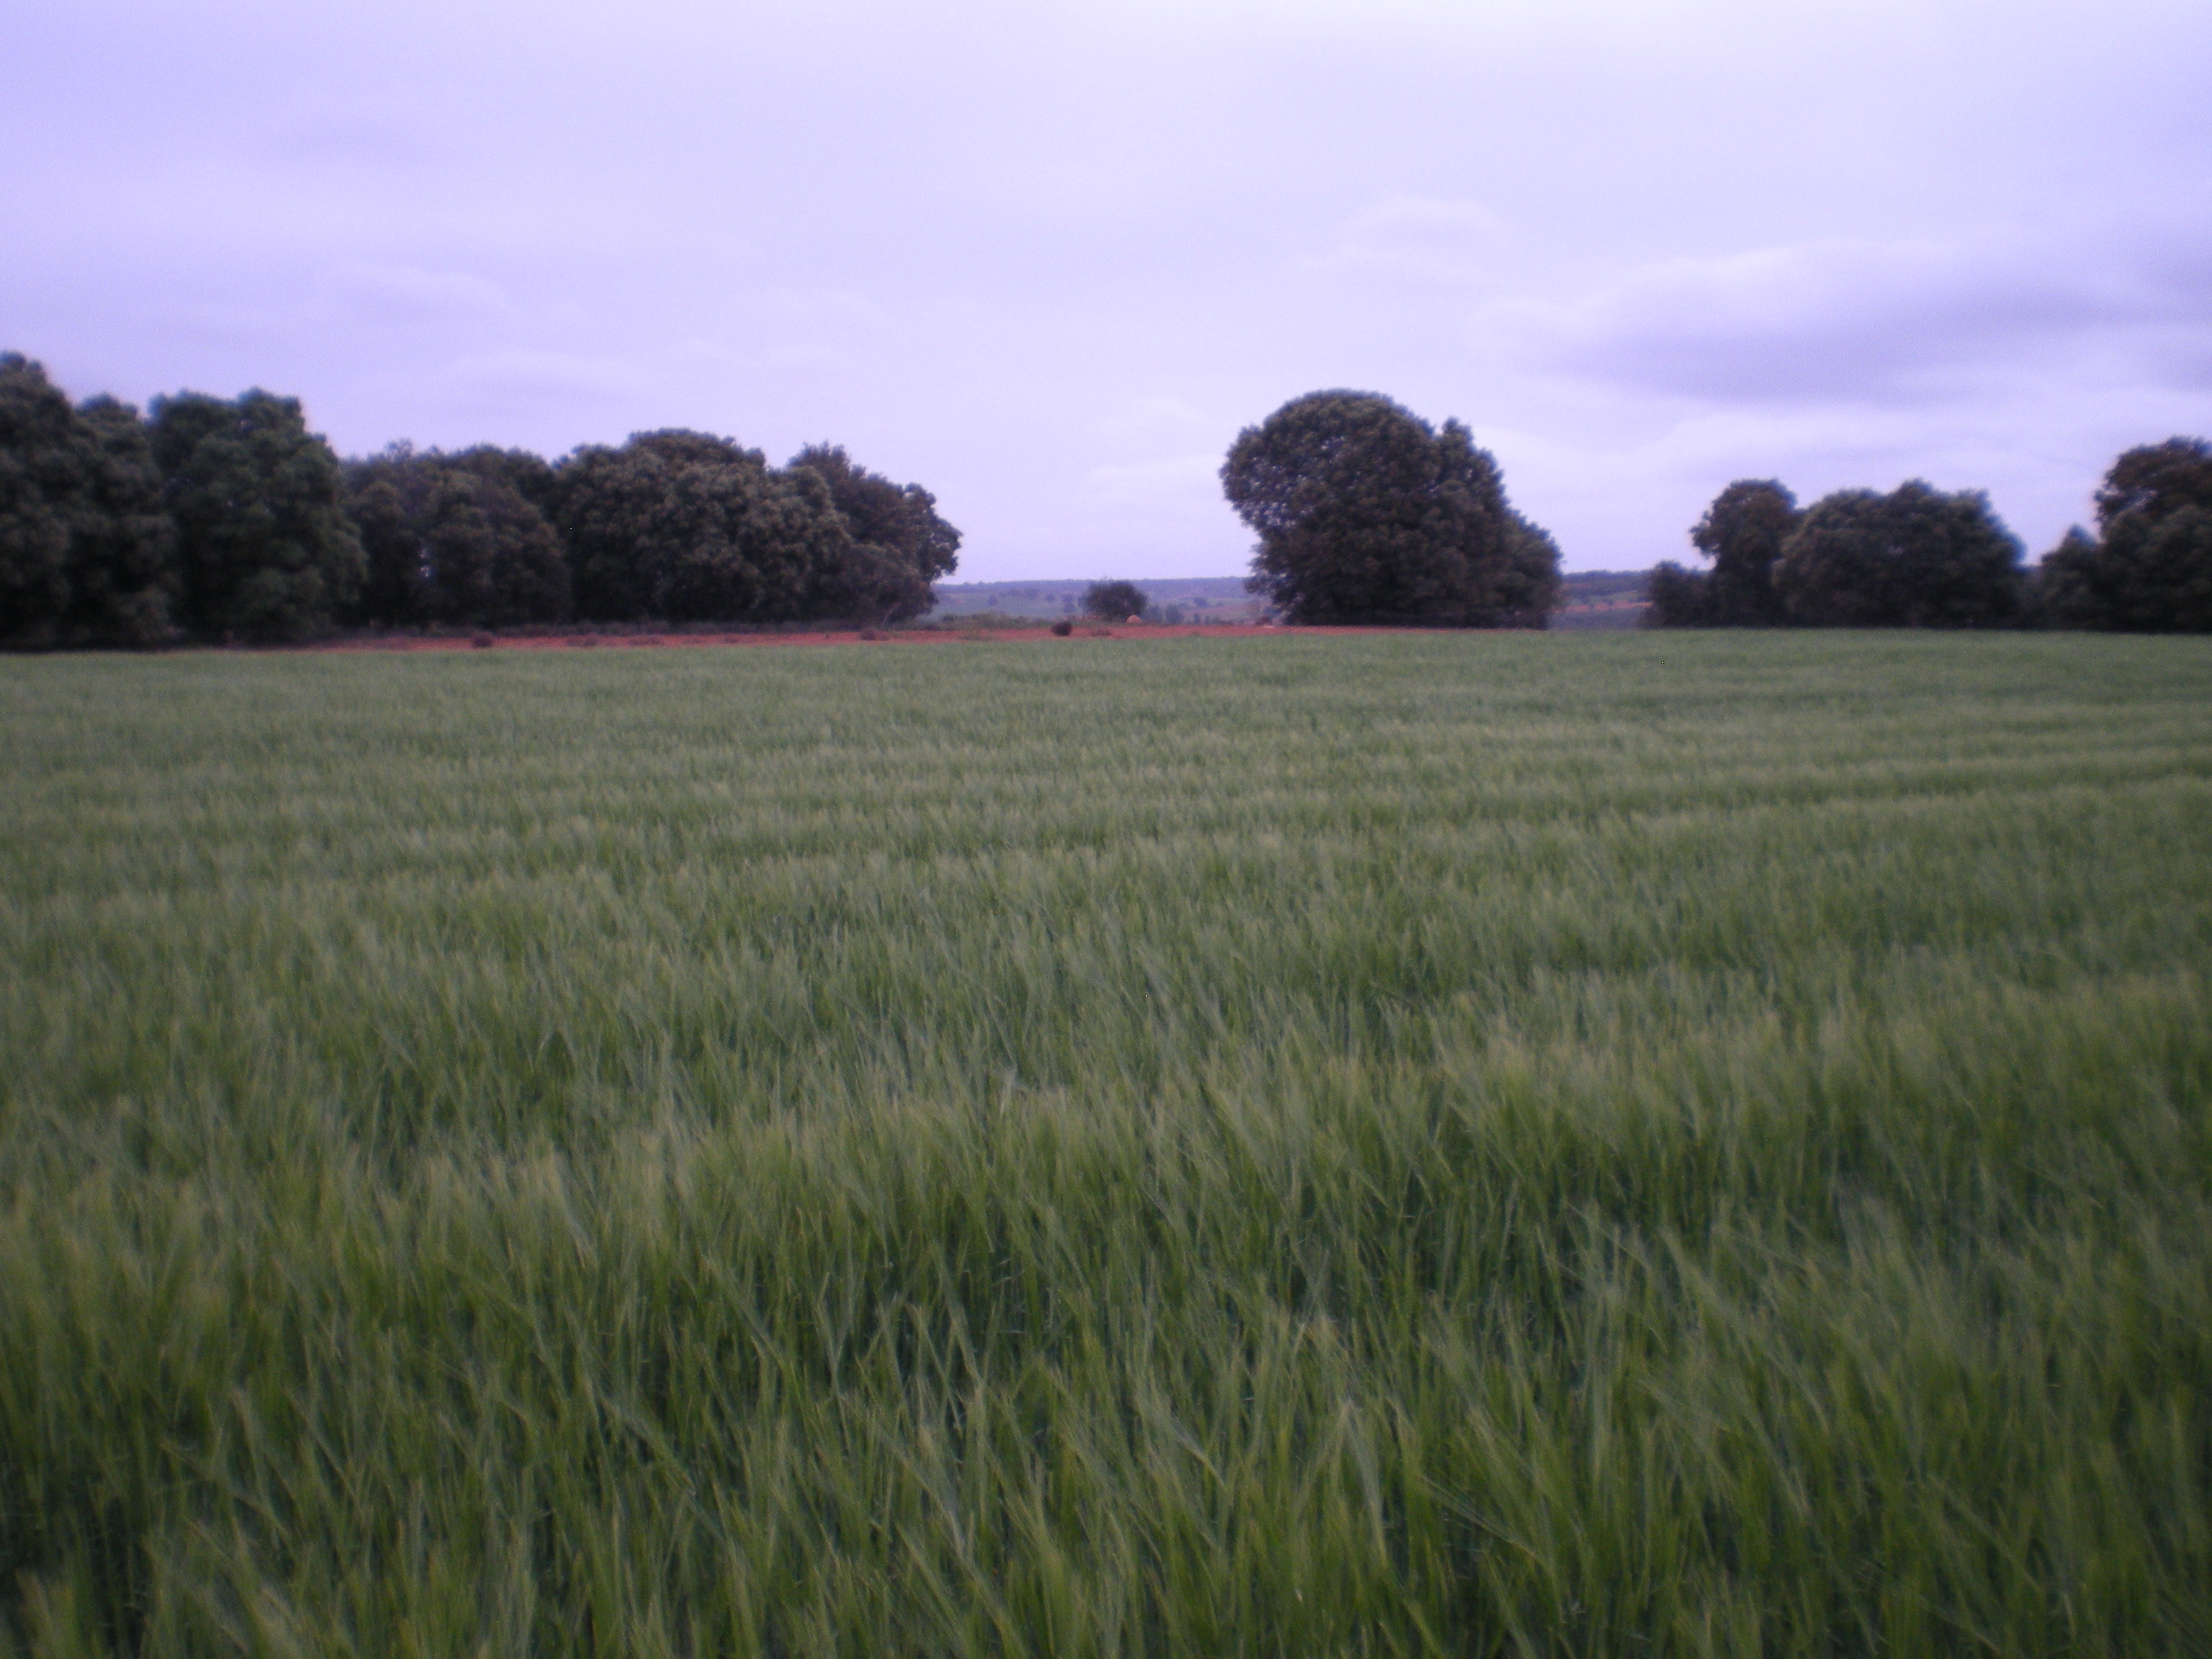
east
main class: Cropland
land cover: Barley
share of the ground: > 75 %
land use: Agriculture (excluding fallow land and kitchen gardens)
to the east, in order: Barley; Fences; Other bare soil; Broadleaved woodland; Tracks; Dry stone walls; Grassland with sparse tree/shrub cover; Fences; Barley; Single bushes/trees; Barley
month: May
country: ES
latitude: 38.8585
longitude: -3.0655
